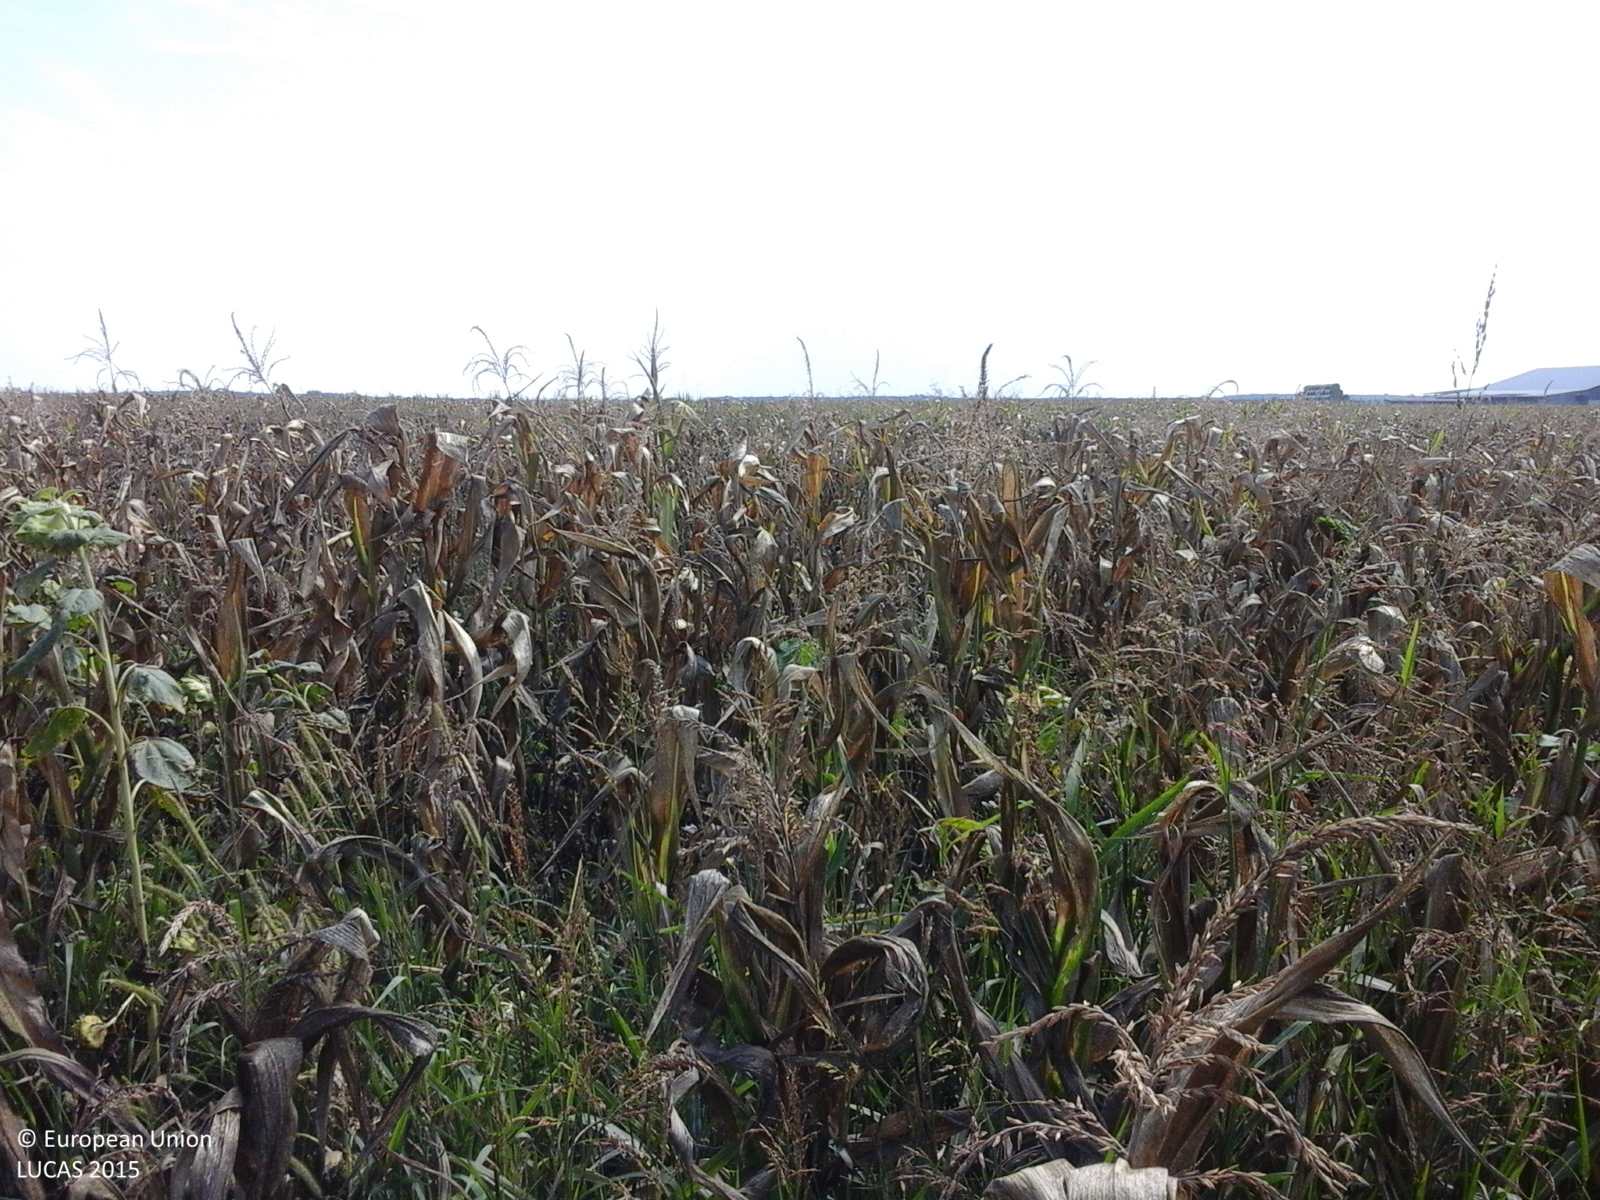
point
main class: Cropland
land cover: Maize
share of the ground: > 75 %
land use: Agriculture (excluding fallow land and kitchen gardens)
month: August
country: RO
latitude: 46.1859
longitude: 21.1350
